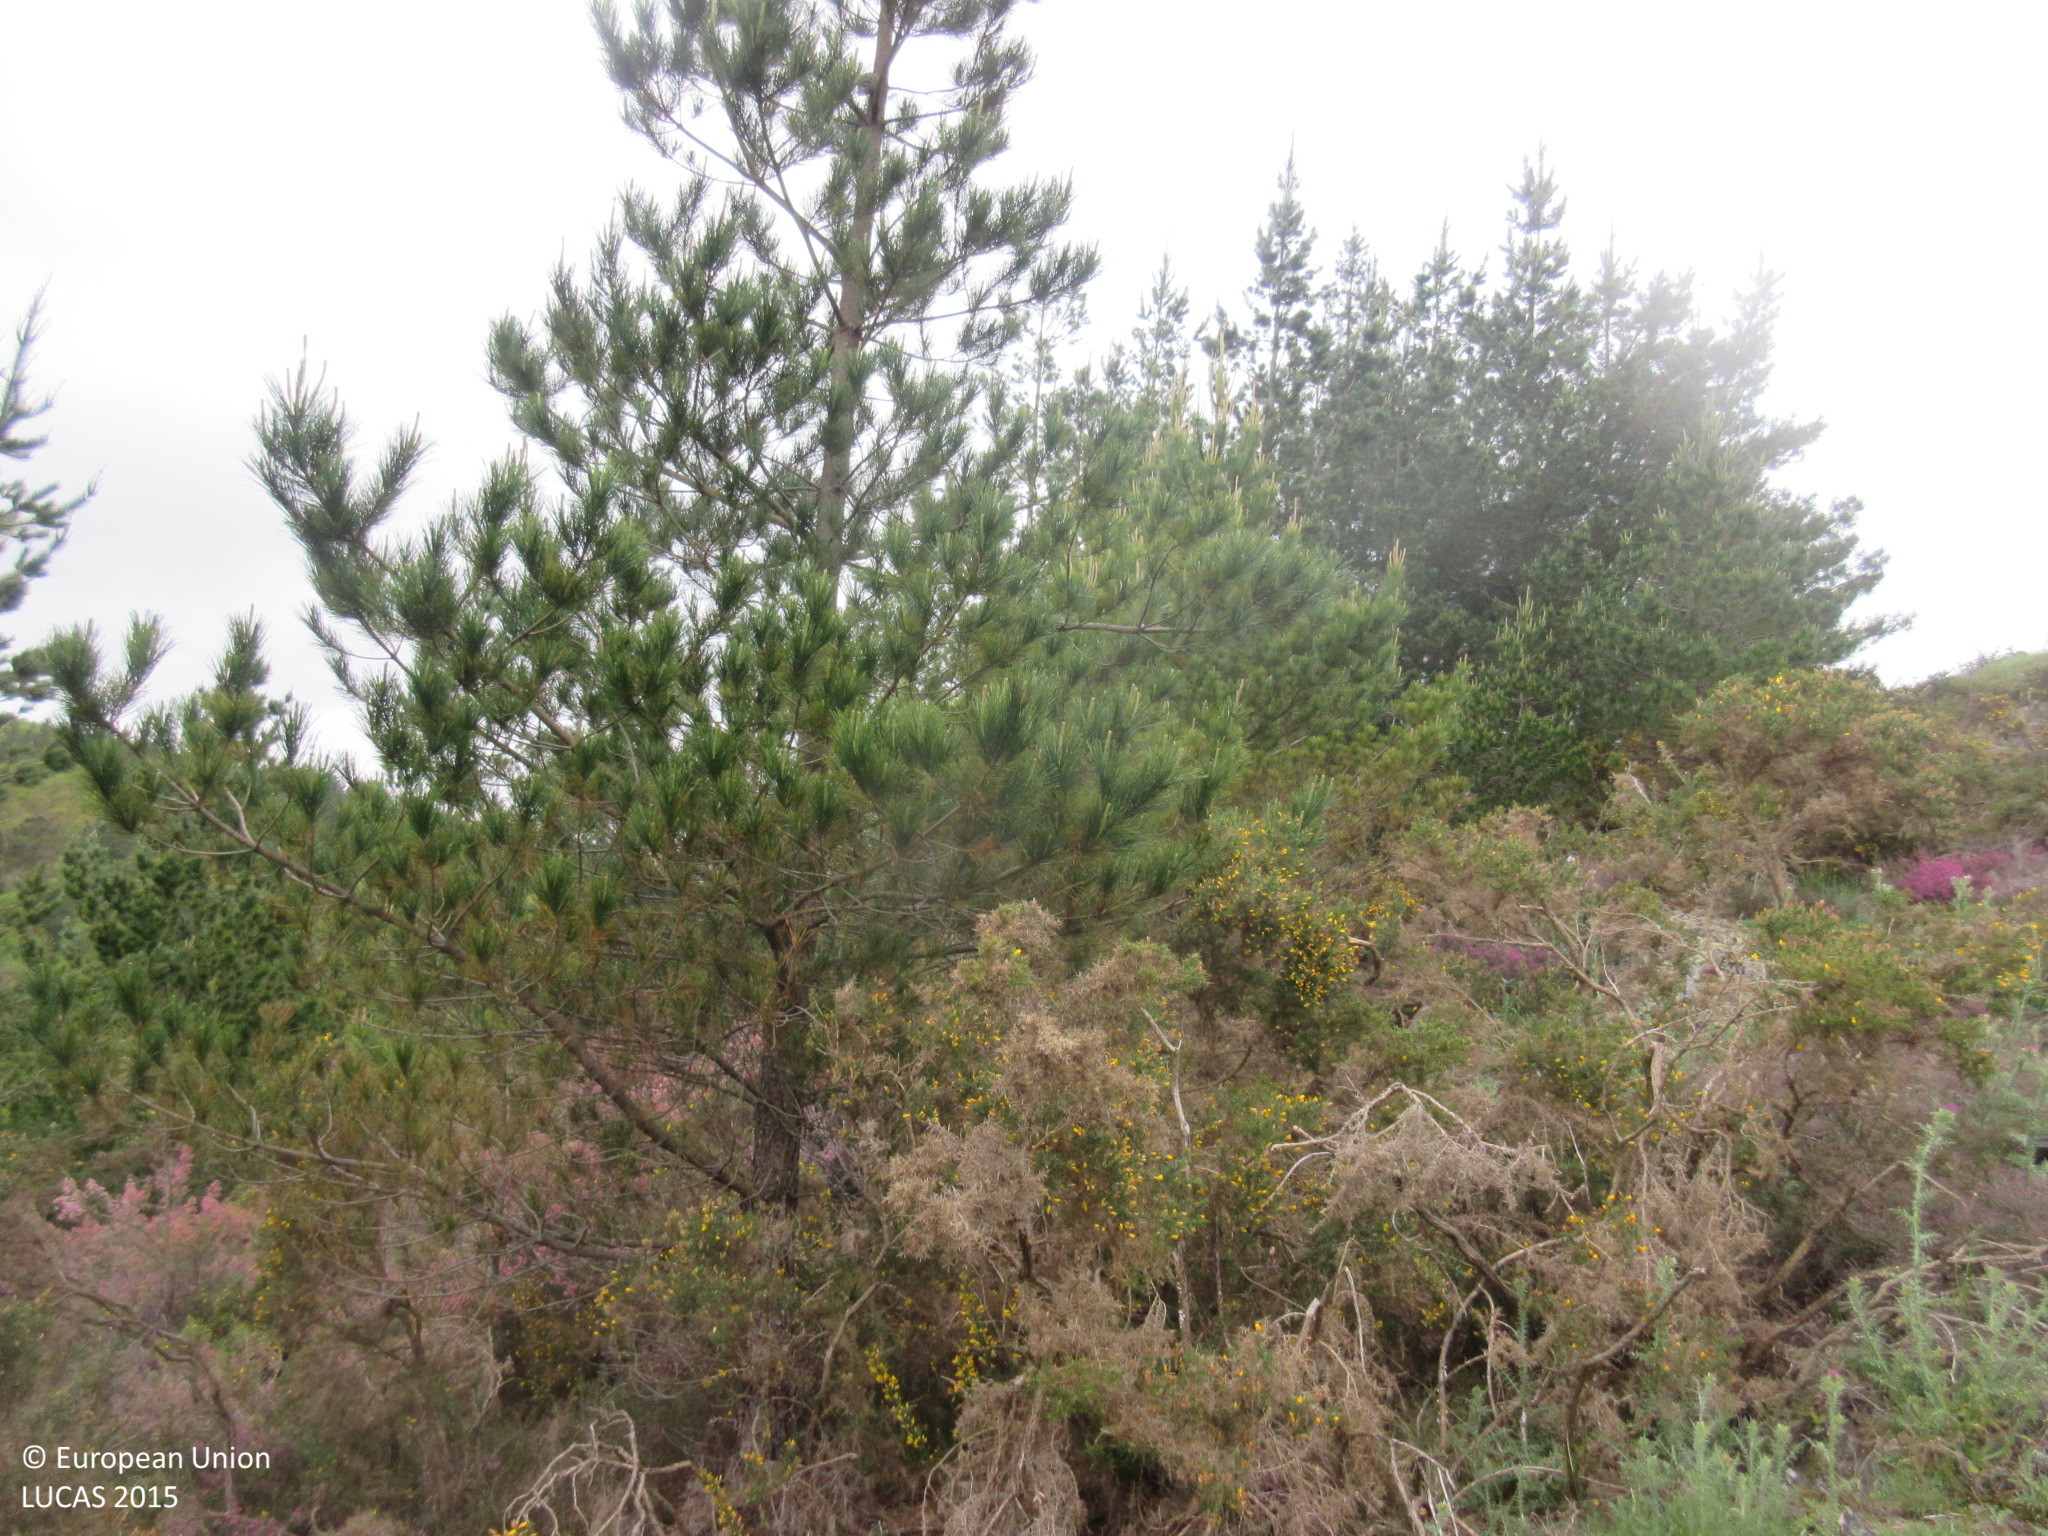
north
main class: Woodland
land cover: Broadleaved woodland
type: acidophilous oak and oak-birch forest
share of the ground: > 75 %
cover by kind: broadleaved forest trees 100 %
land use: Semi-natural and natural areas not in use
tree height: > 5 m
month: April
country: ES
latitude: 43.2562
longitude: -6.9519
